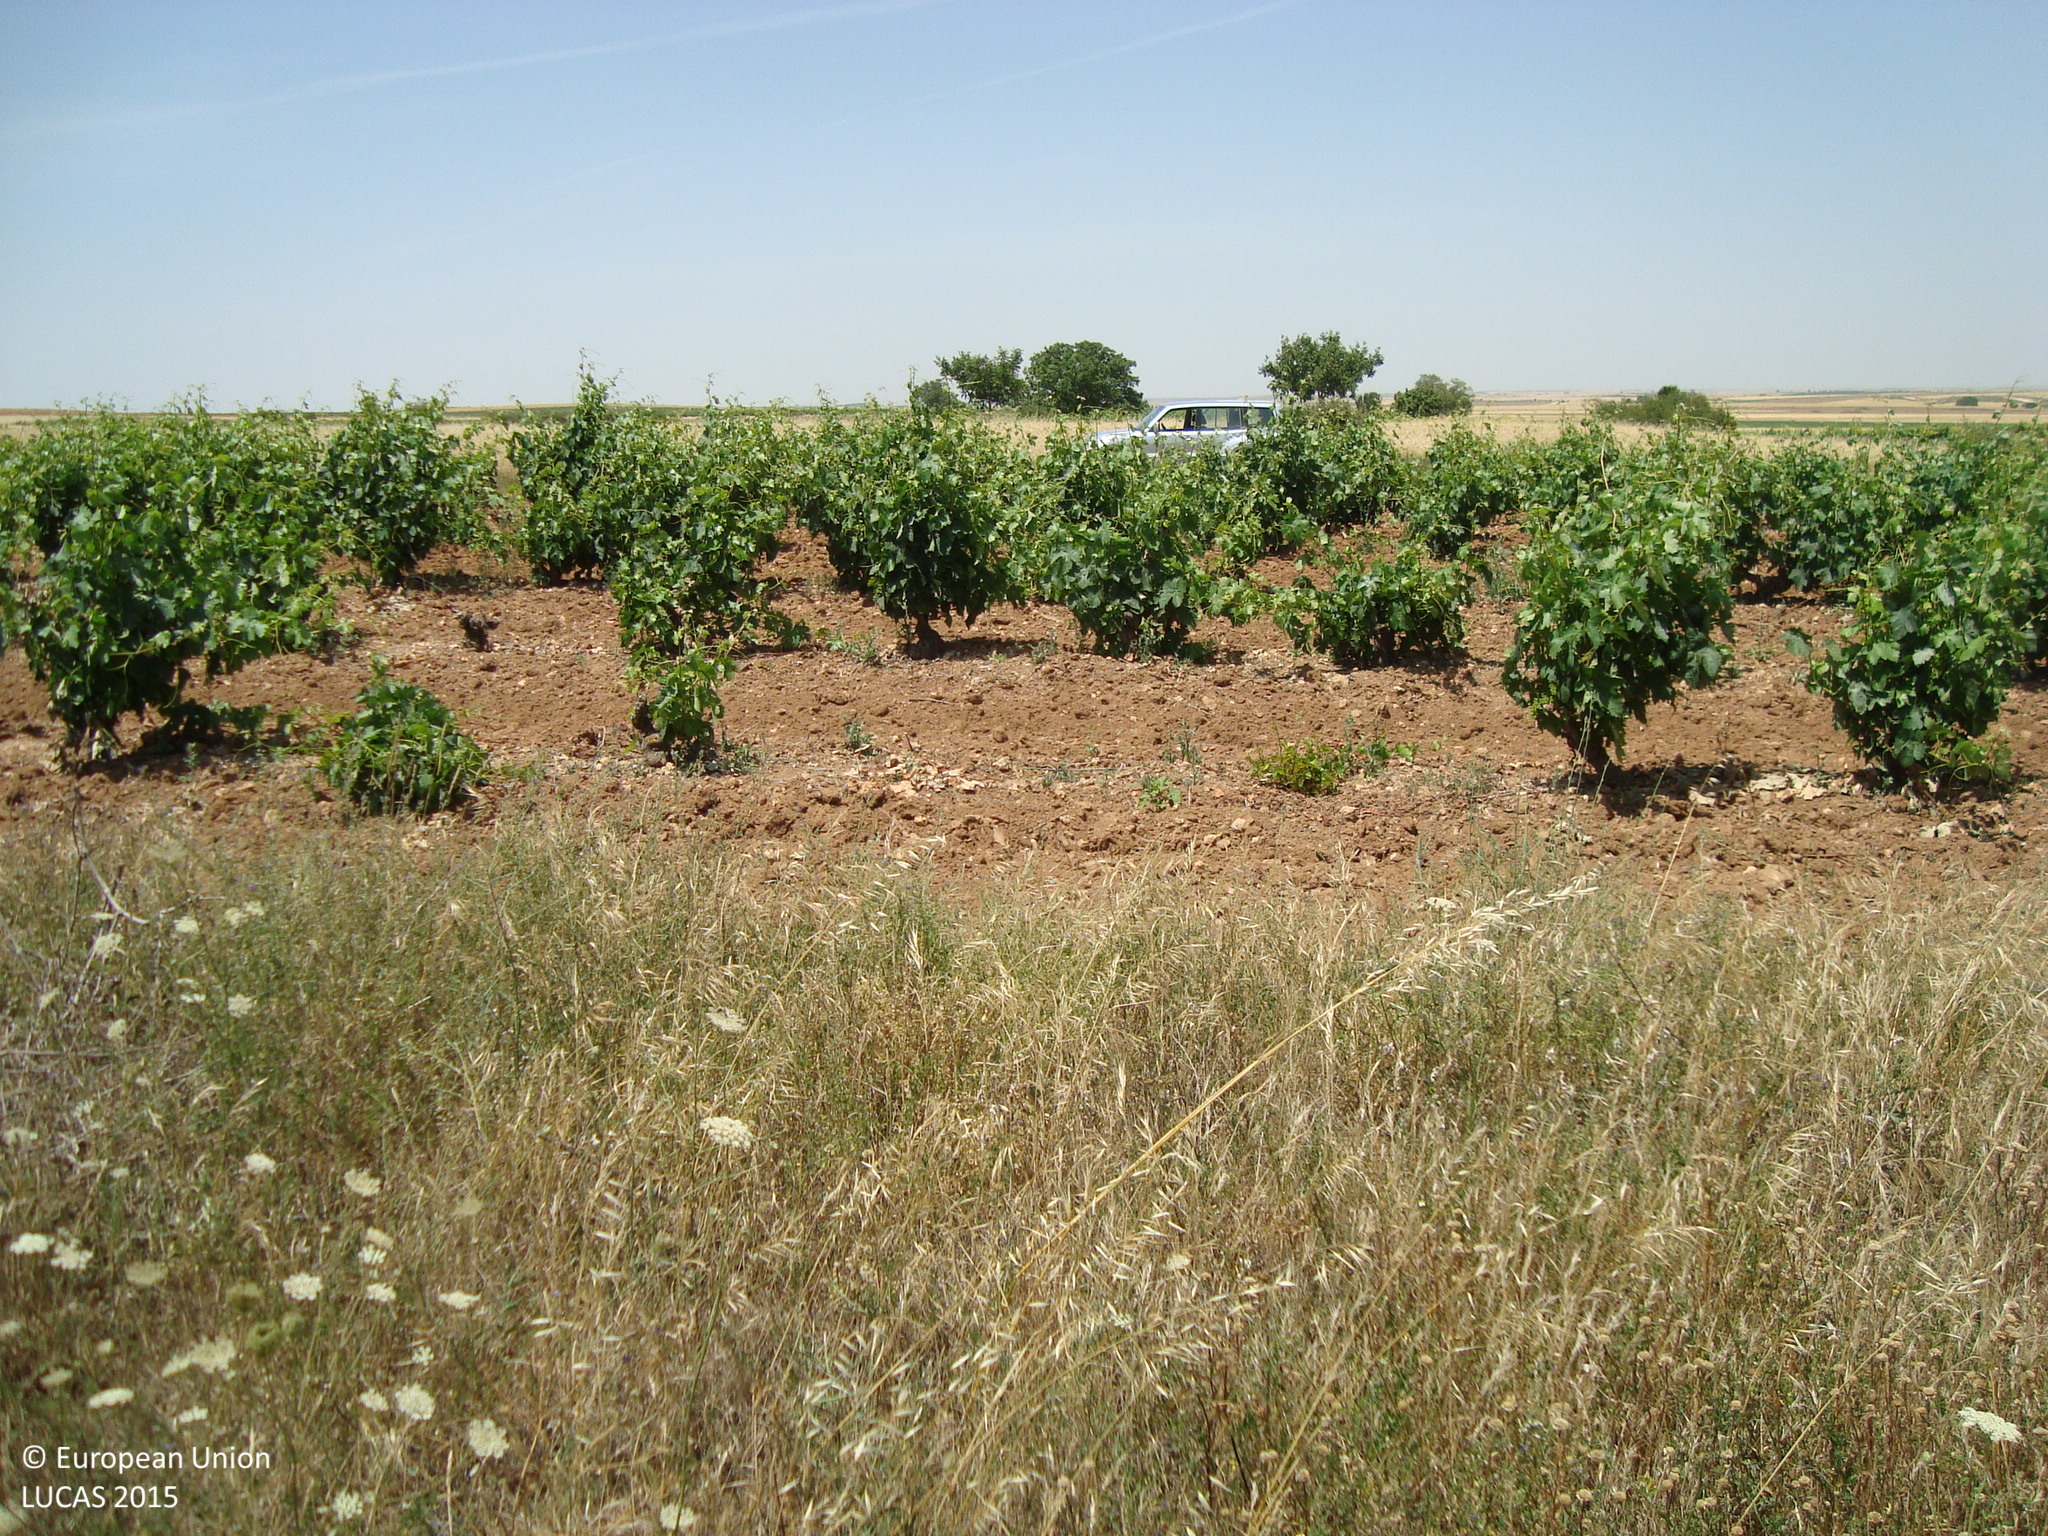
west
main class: Grassland
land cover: Grassland without tree/shrub cover
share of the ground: 50 - 75 %
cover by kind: herbaceous plants 60 %, unconsolidated bare surface 20 %
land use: Abandoned areas
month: July
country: ES
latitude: 41.8008
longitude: -3.7636
